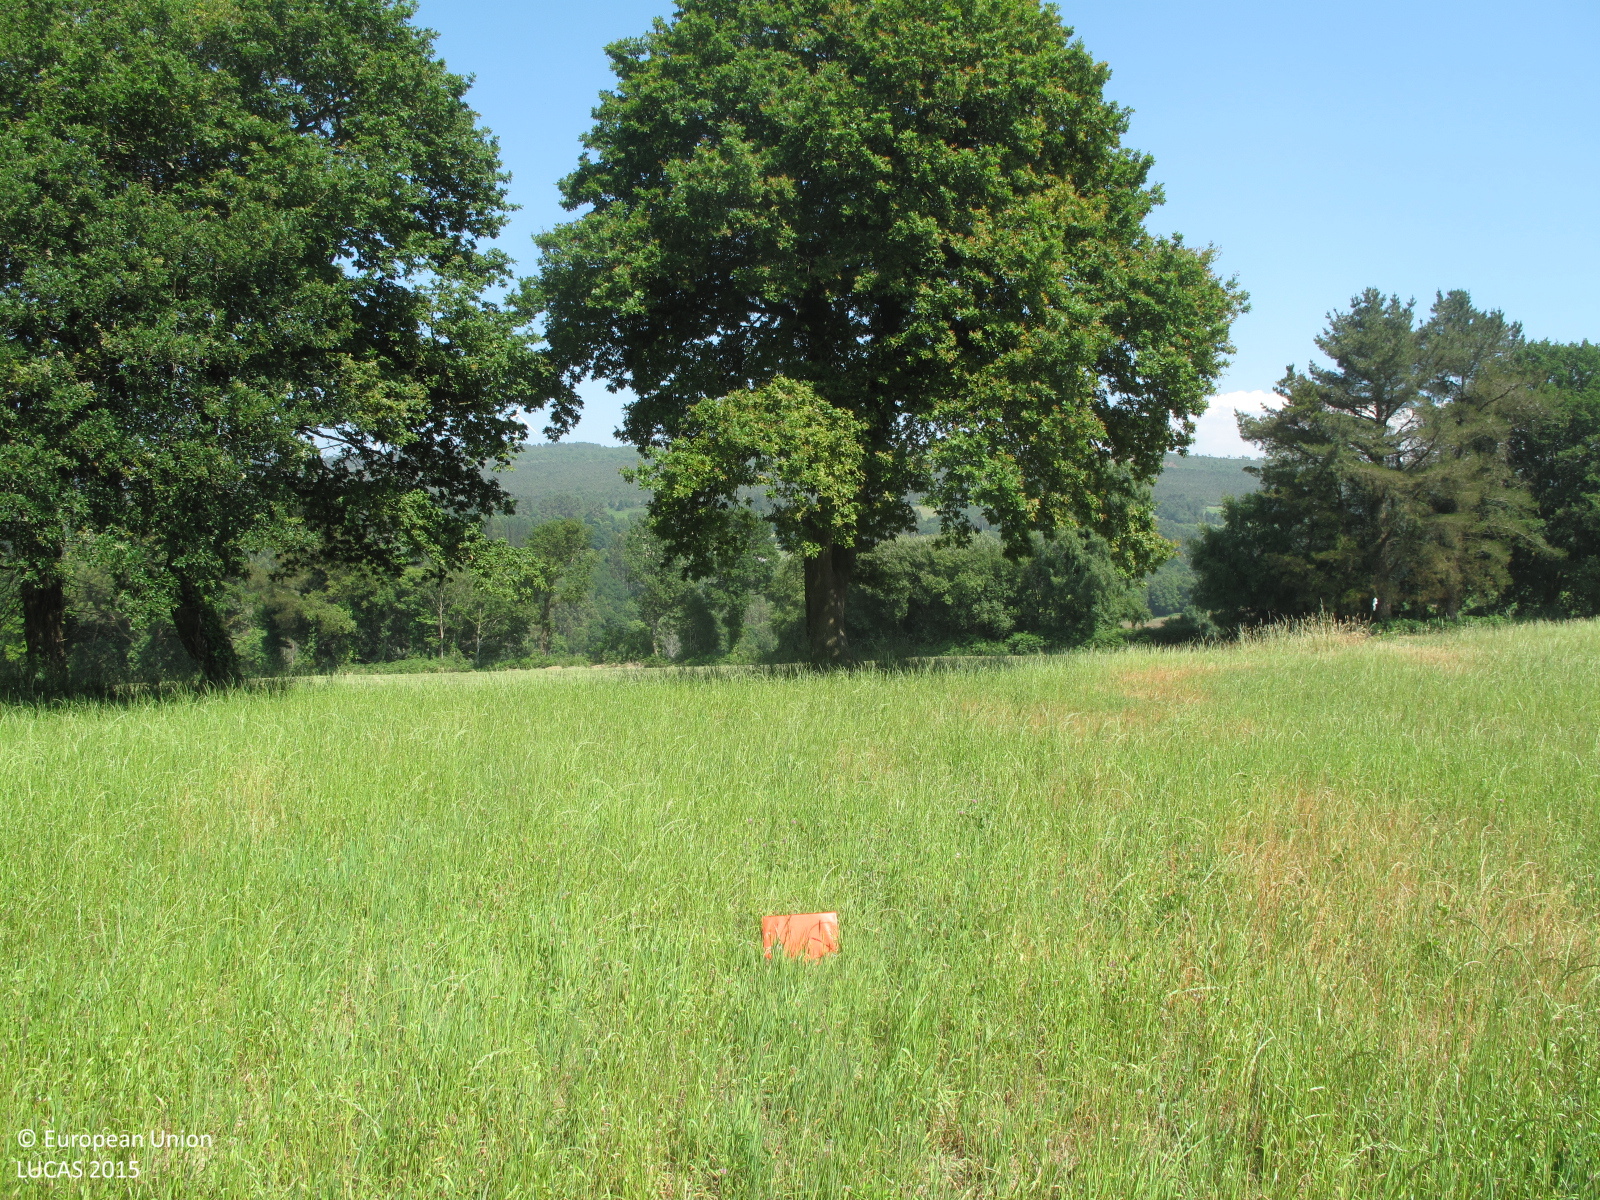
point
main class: Grassland
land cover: Grassland without tree/shrub cover
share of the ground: > 75 %
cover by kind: herbaceous plants 100 %
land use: Agriculture (excluding fallow land and kitchen gardens)
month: June
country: ES
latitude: 43.3035
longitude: -7.9550
